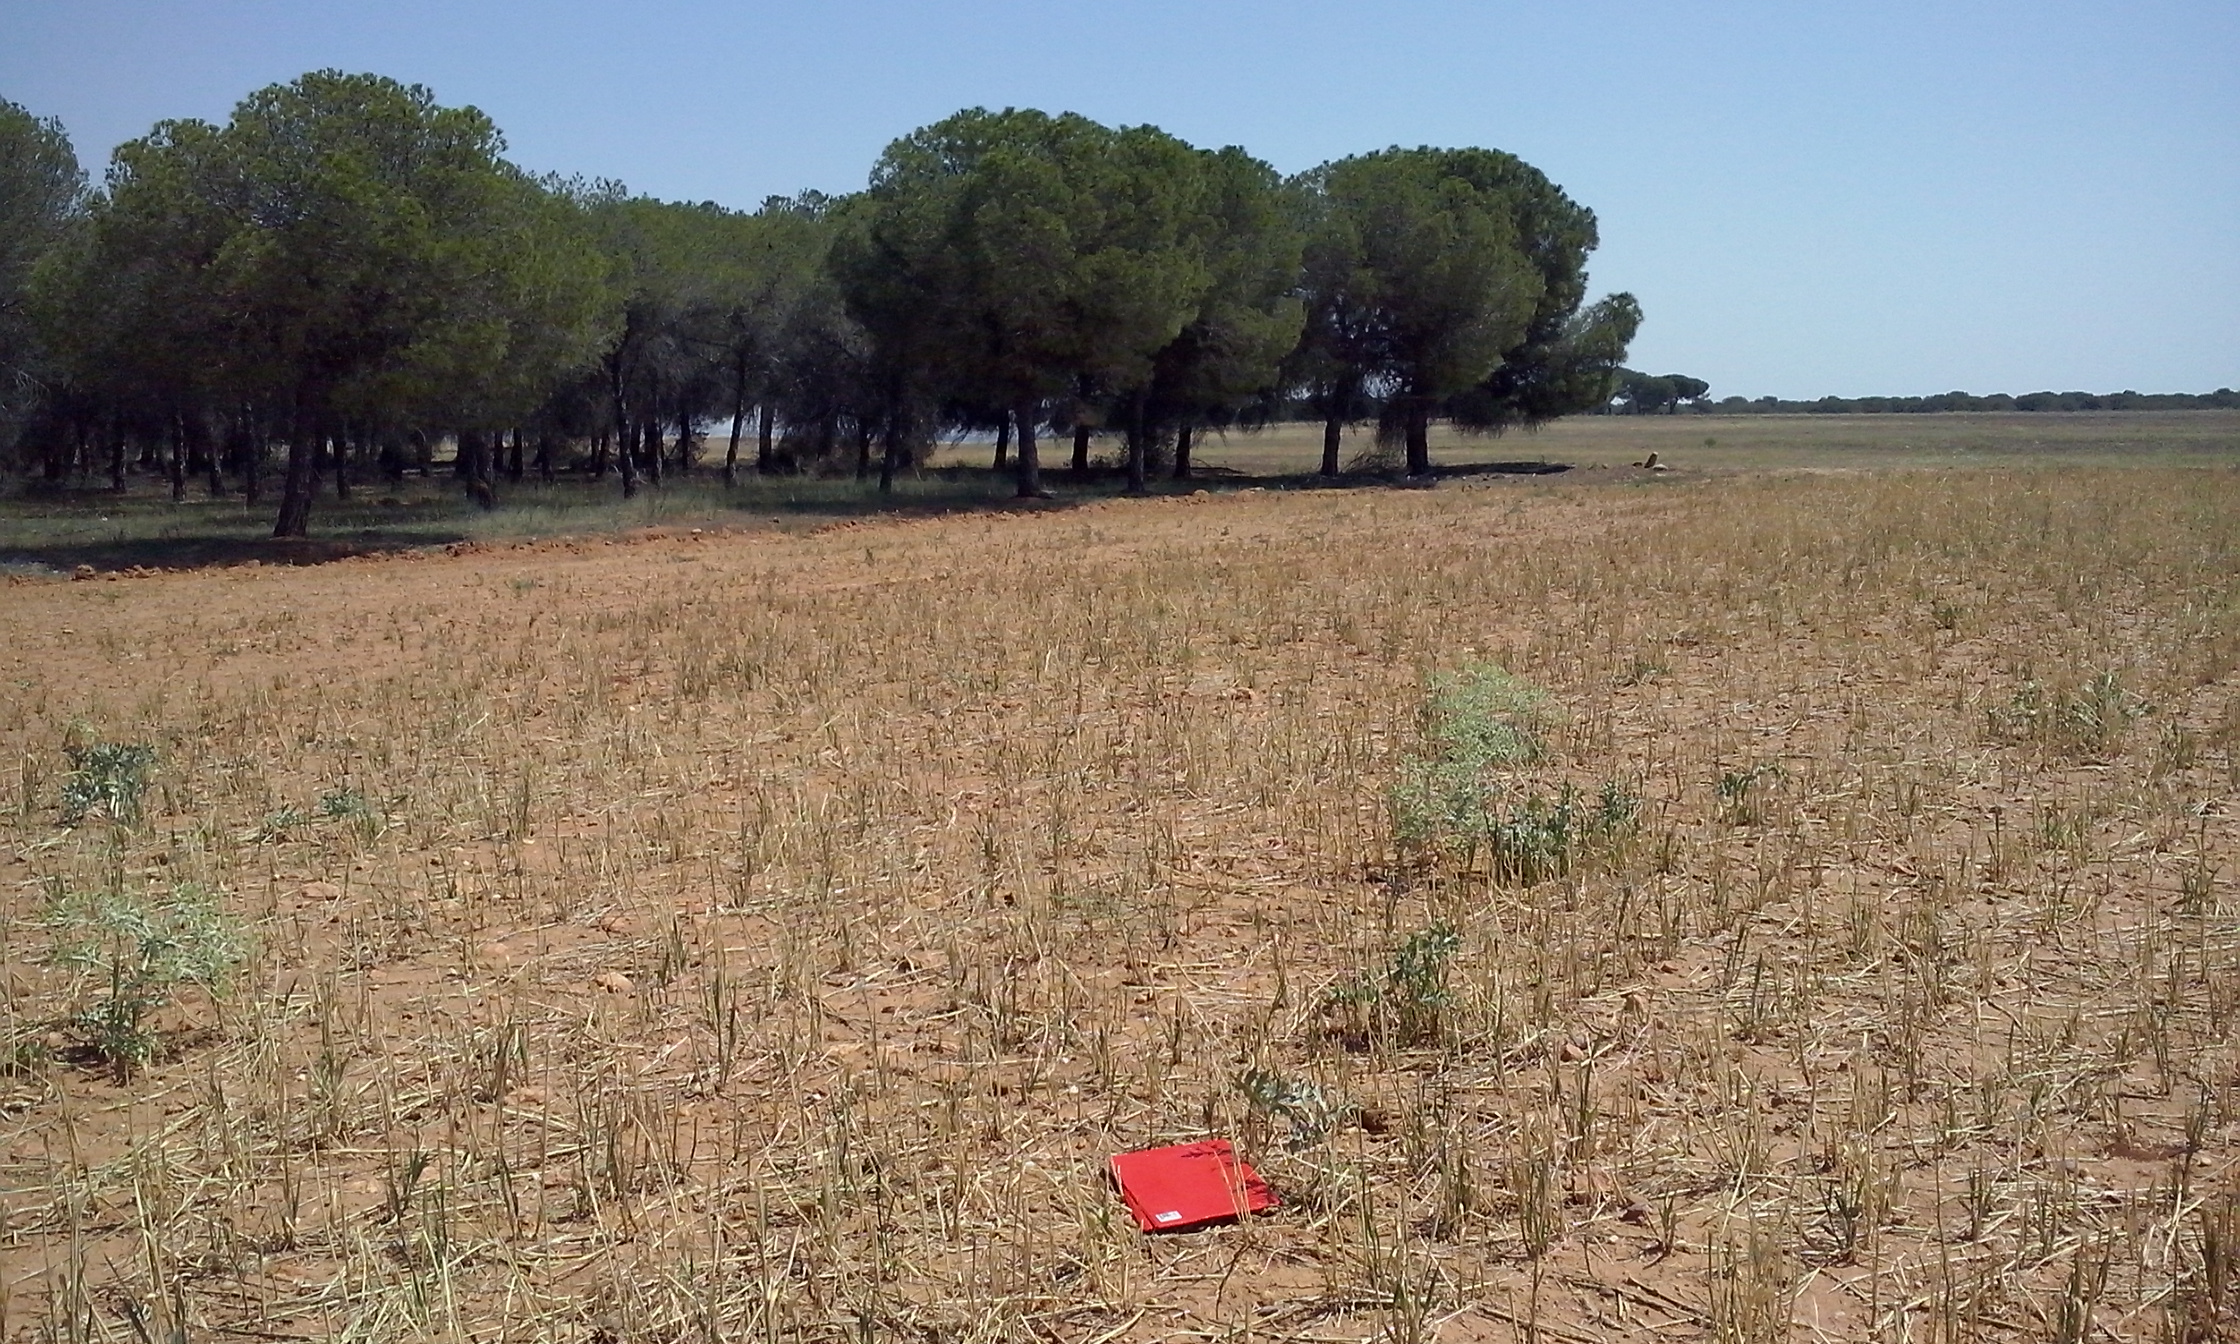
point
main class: Cropland
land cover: Oats
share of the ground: 25 - 50 %
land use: Agriculture (excluding fallow land and kitchen gardens)
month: June
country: ES
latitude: 41.4738
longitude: -5.1261
